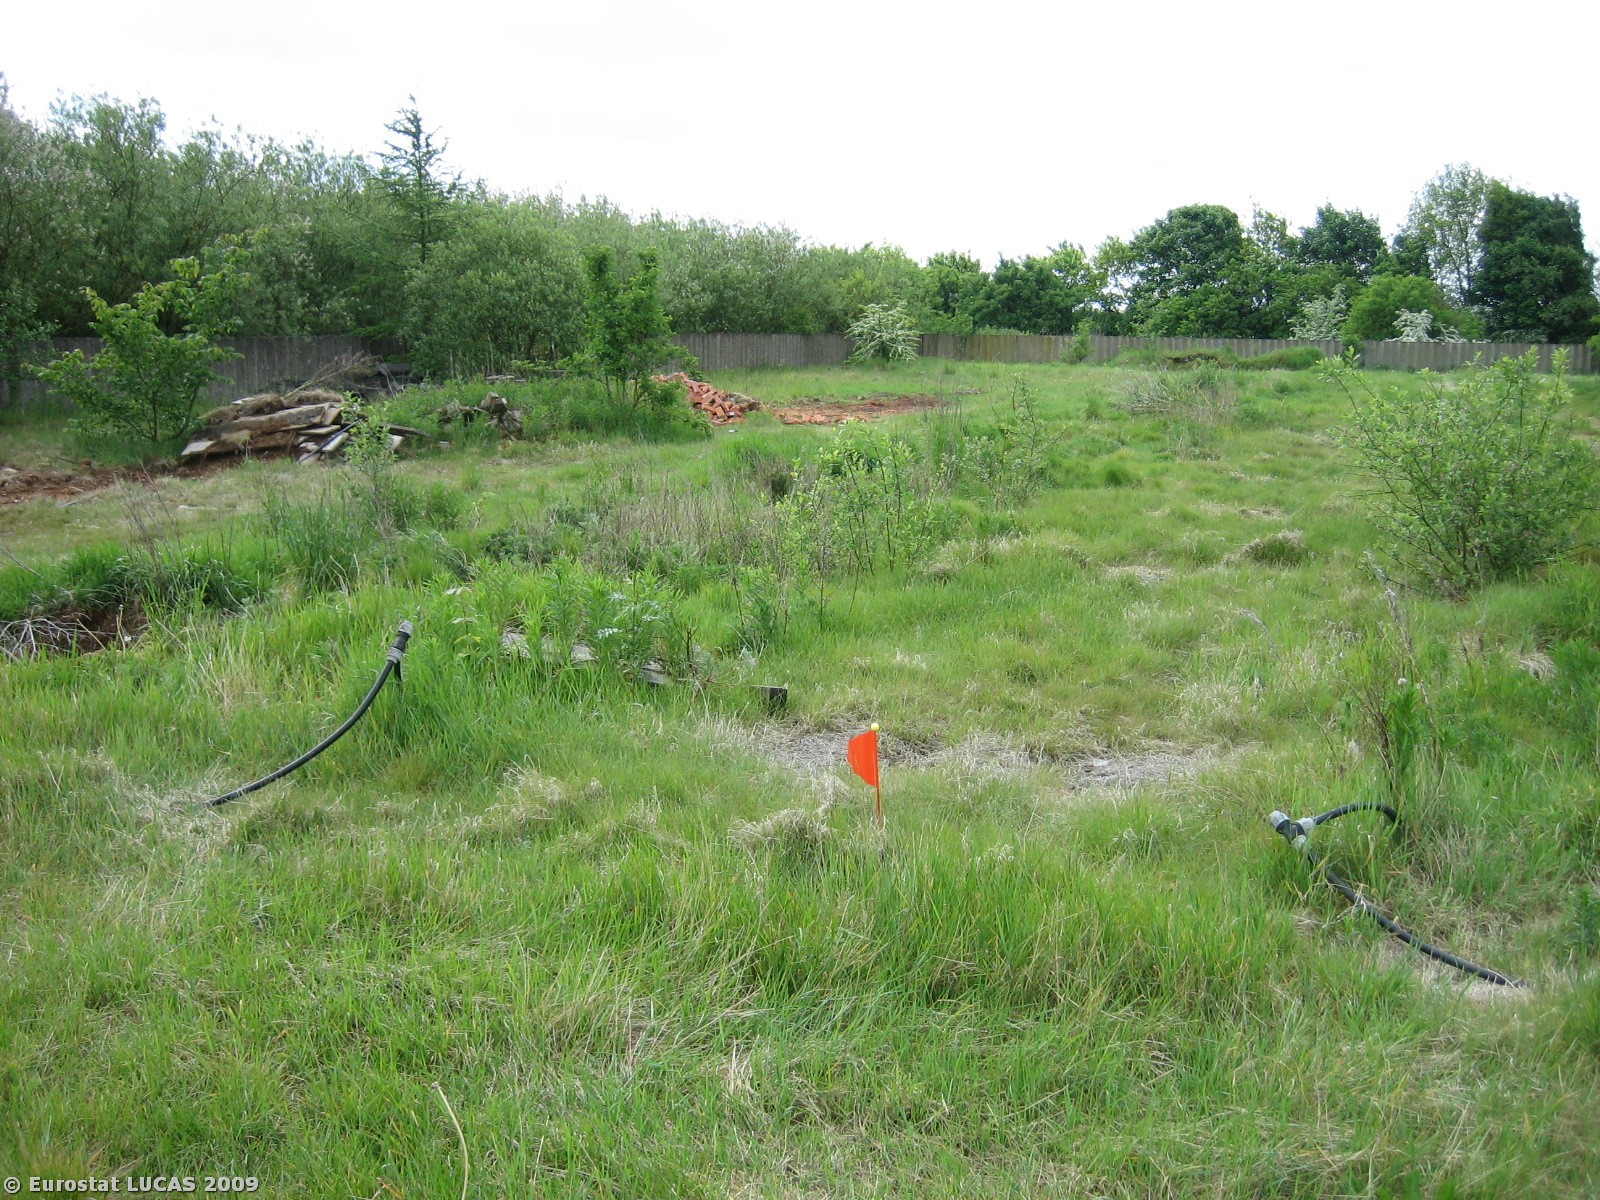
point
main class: Grassland
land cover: Grassland with sparse tree/shrub cover
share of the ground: > 75 %
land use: Logistics and storage
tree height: > 5 m
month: May
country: DK
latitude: 56.0922
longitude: 8.7959
